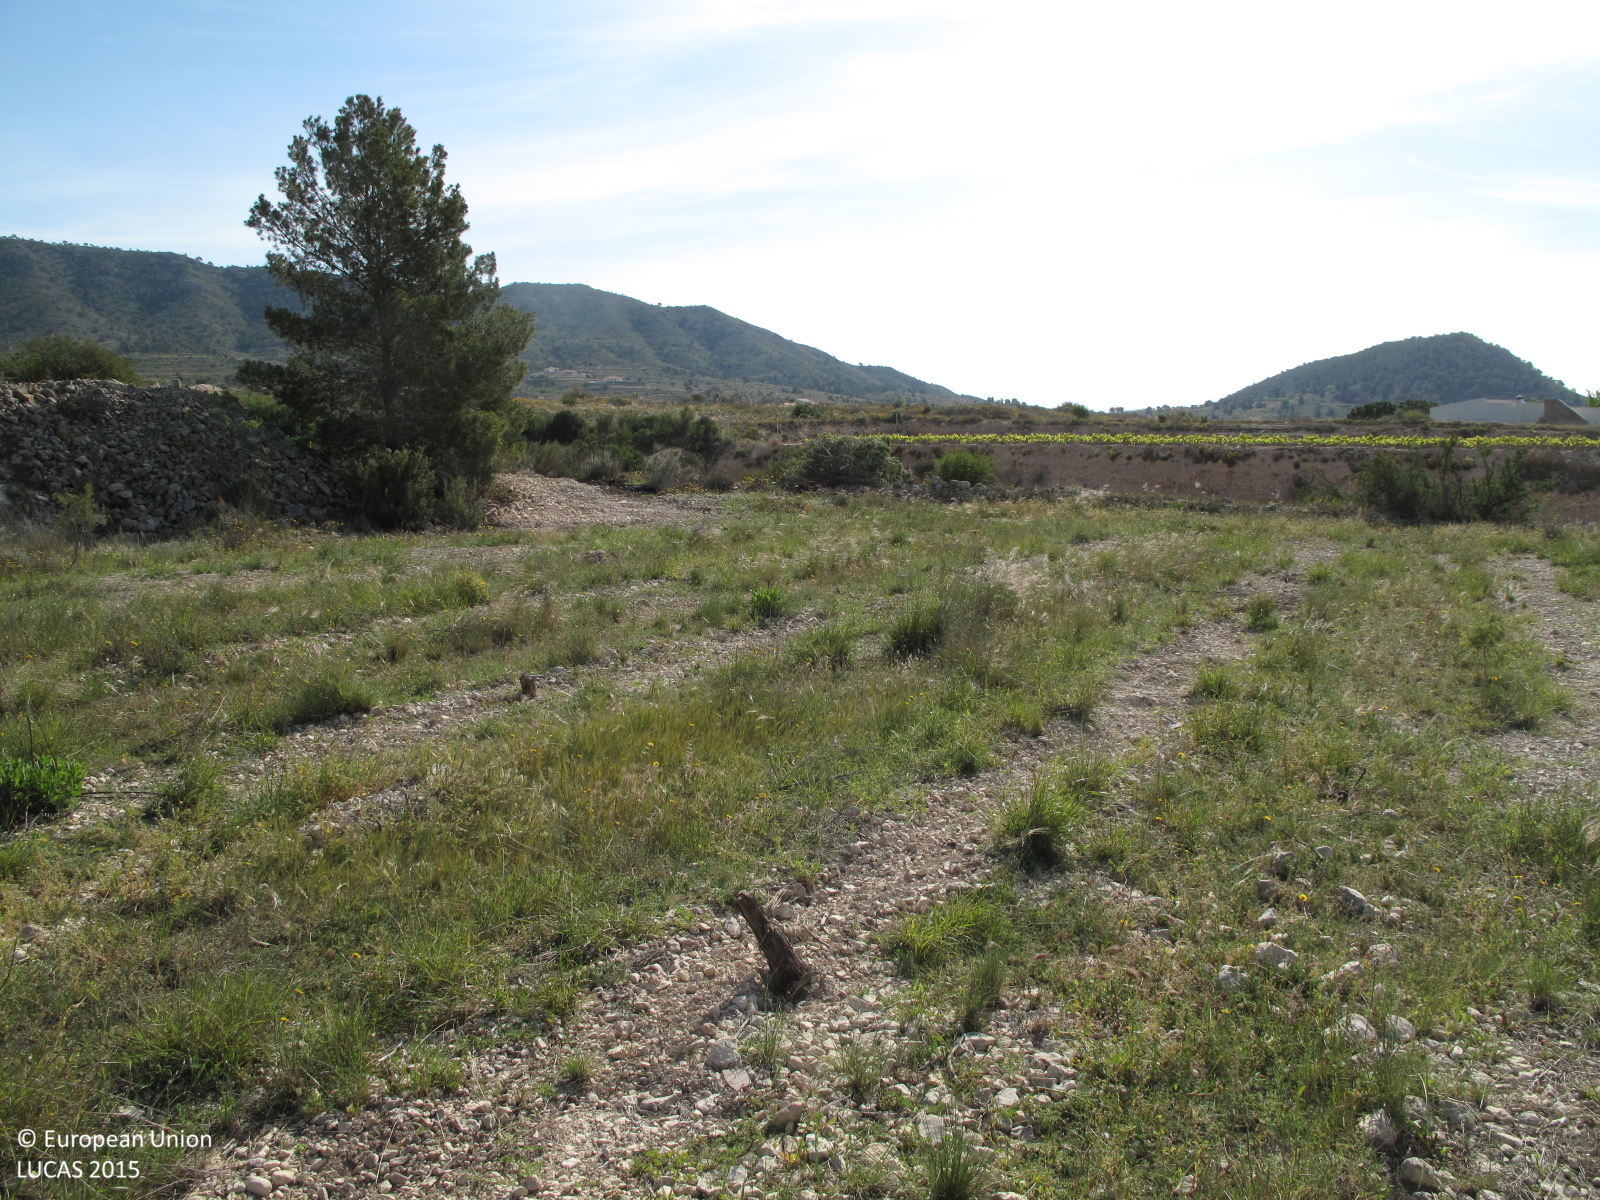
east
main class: Grassland
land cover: Spontaneously vegetated surfaces
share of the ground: 50 - 75 %
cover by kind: herbaceous plants 60 %, unconsolidated bare surface 40 %
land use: Abandoned areas
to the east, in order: Spontaneously vegetated surfaces; Shrubland with sparse tree cover; Other bare soil; Shrubland with sparse tree cover; Tracks; Grassland with sparse tree/shrub cover
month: April
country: ES
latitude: 38.3806
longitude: -0.8969
